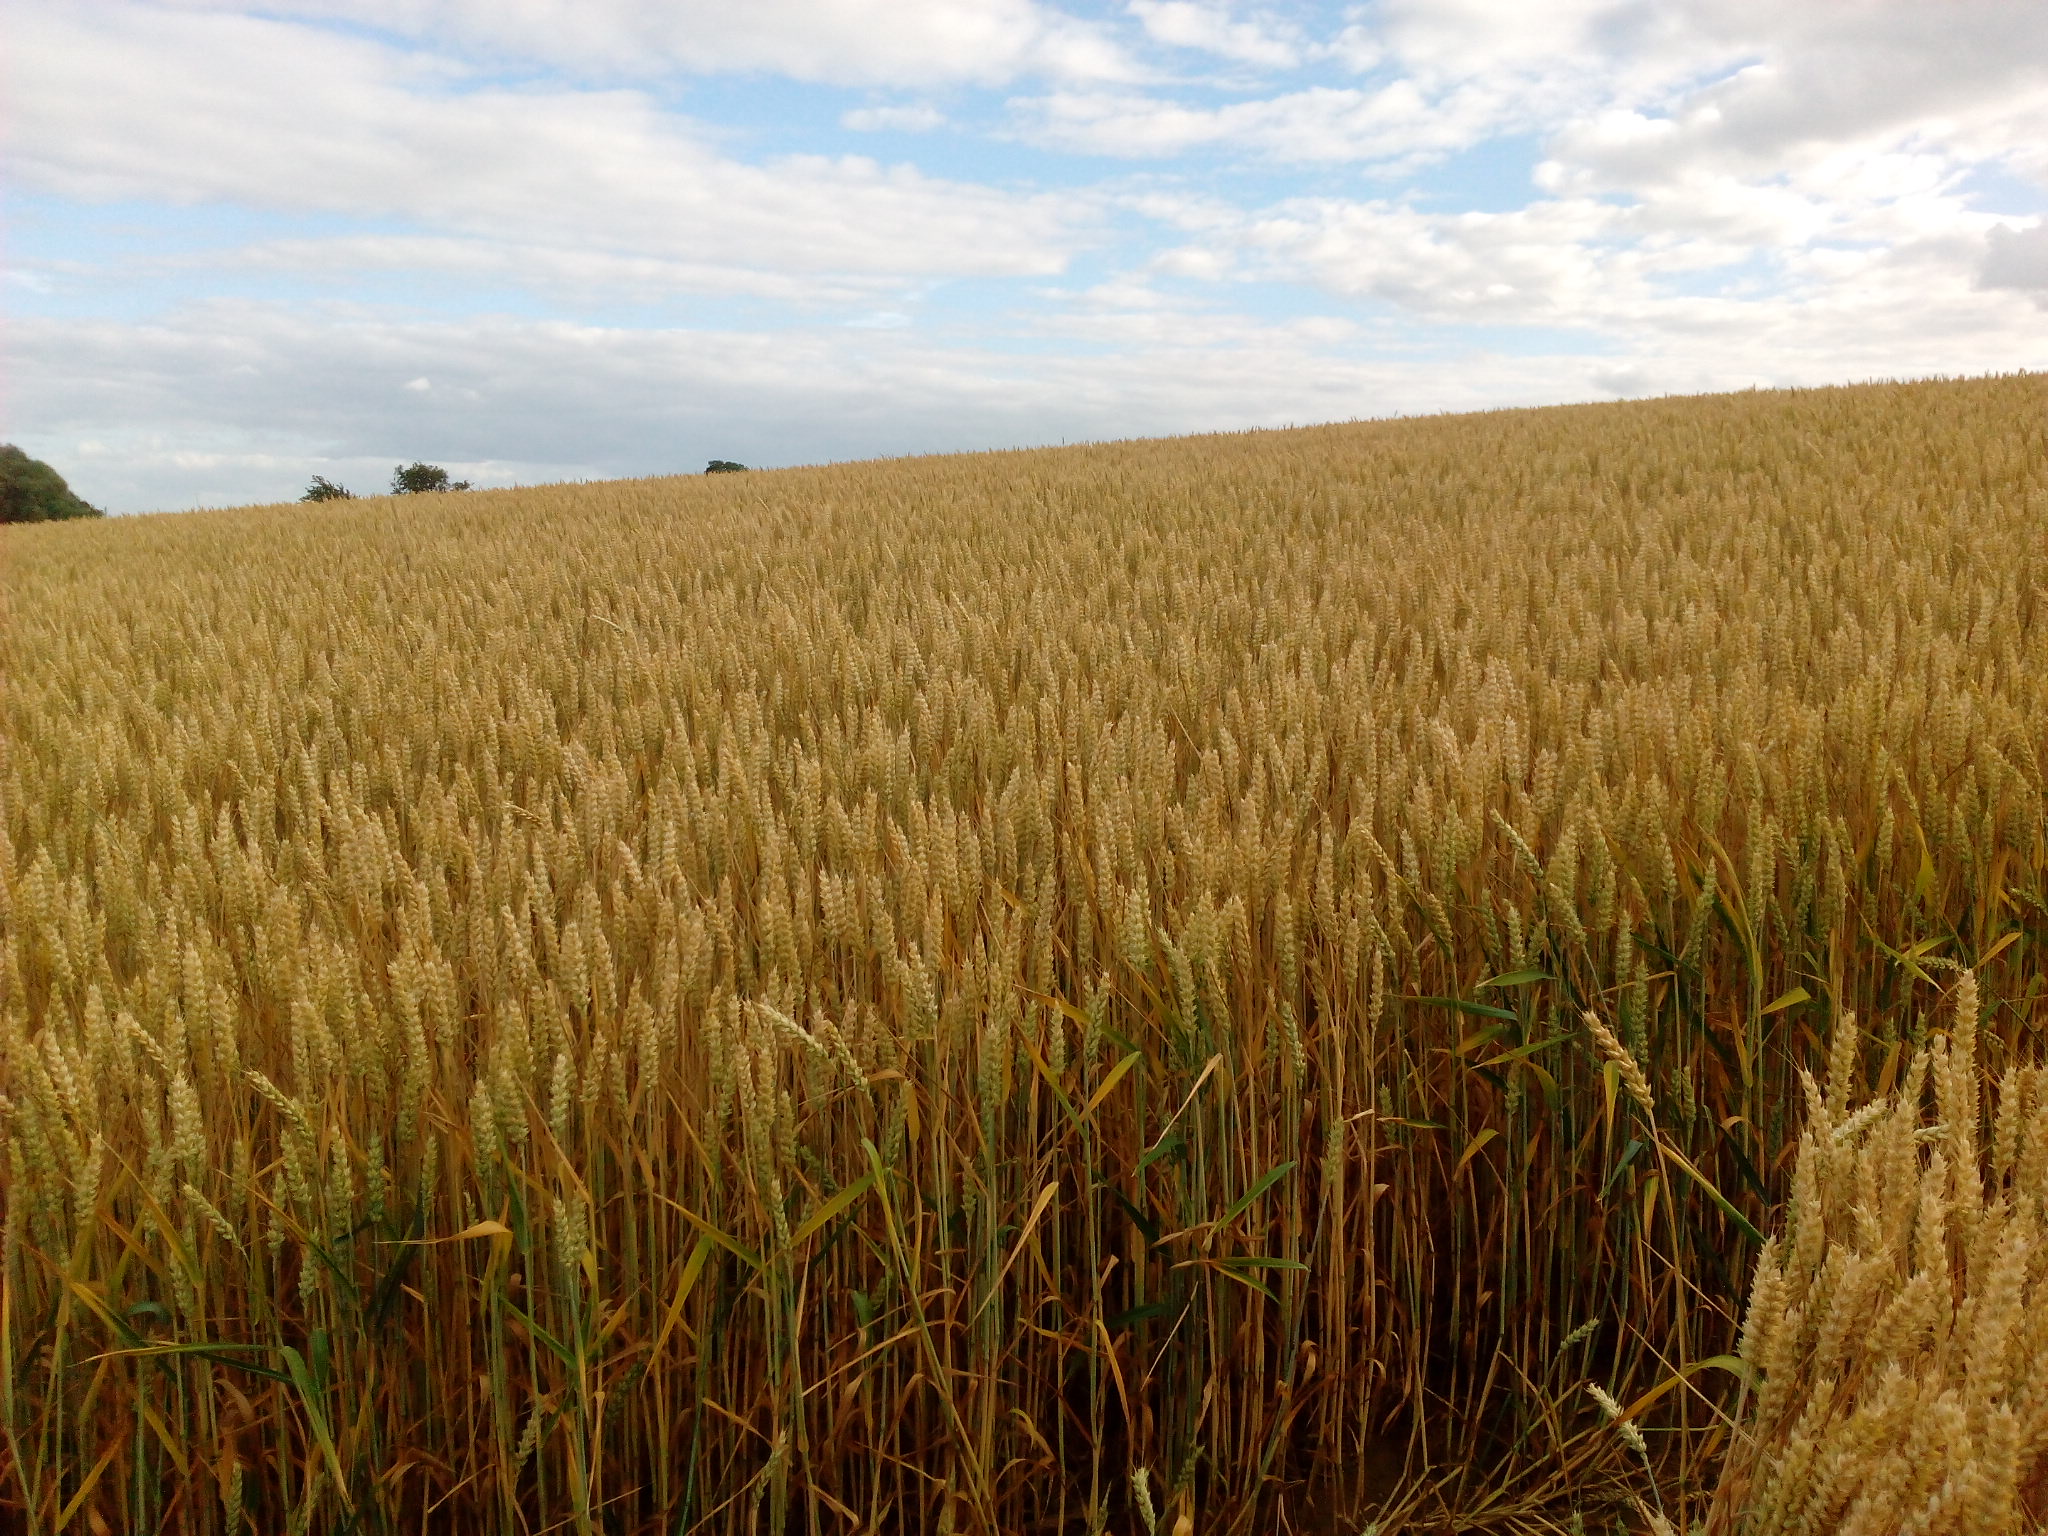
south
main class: Cropland
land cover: Common wheat
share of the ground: > 75 %
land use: Agriculture (excluding fallow land and kitchen gardens)
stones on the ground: < 10 %
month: July
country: DE
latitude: 53.2936
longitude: 14.1864
